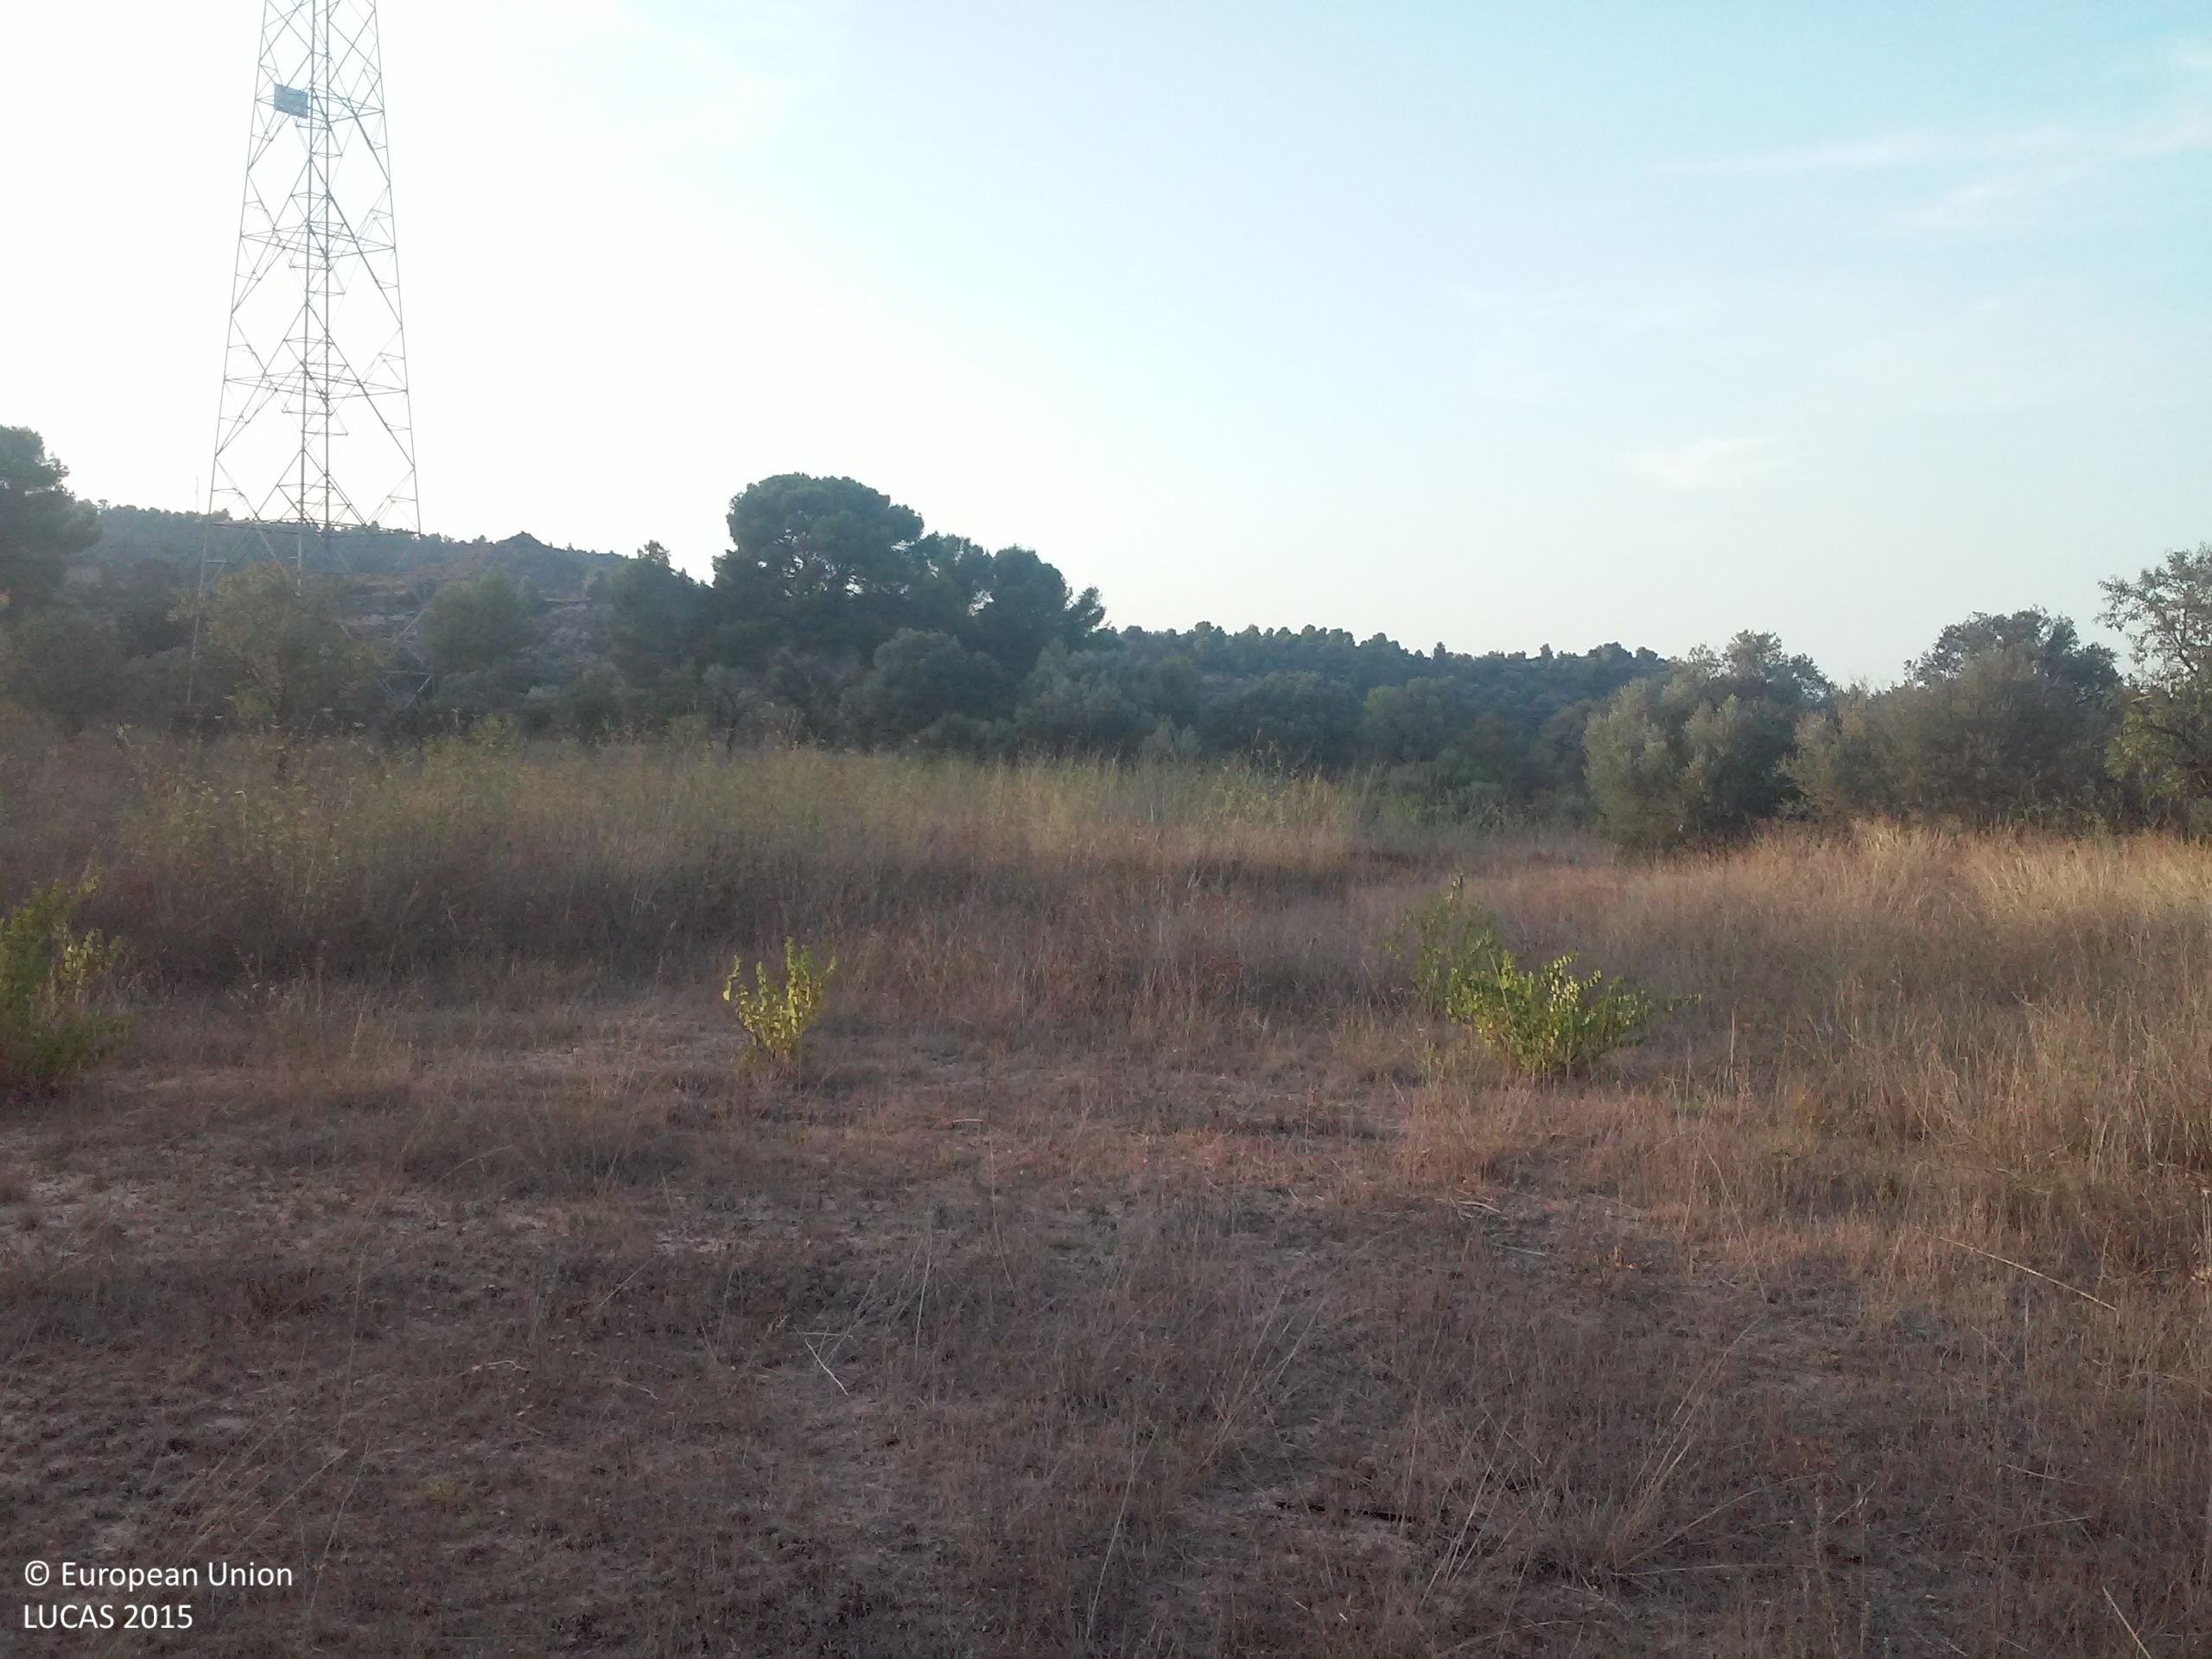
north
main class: Grassland
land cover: Grassland without tree/shrub cover
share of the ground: > 75 %
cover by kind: herbaceous plants 90 %, consolidated bare surface 10 %
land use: Semi-natural and natural areas not in use
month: August
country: ES
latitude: 41.1583
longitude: 0.5647
